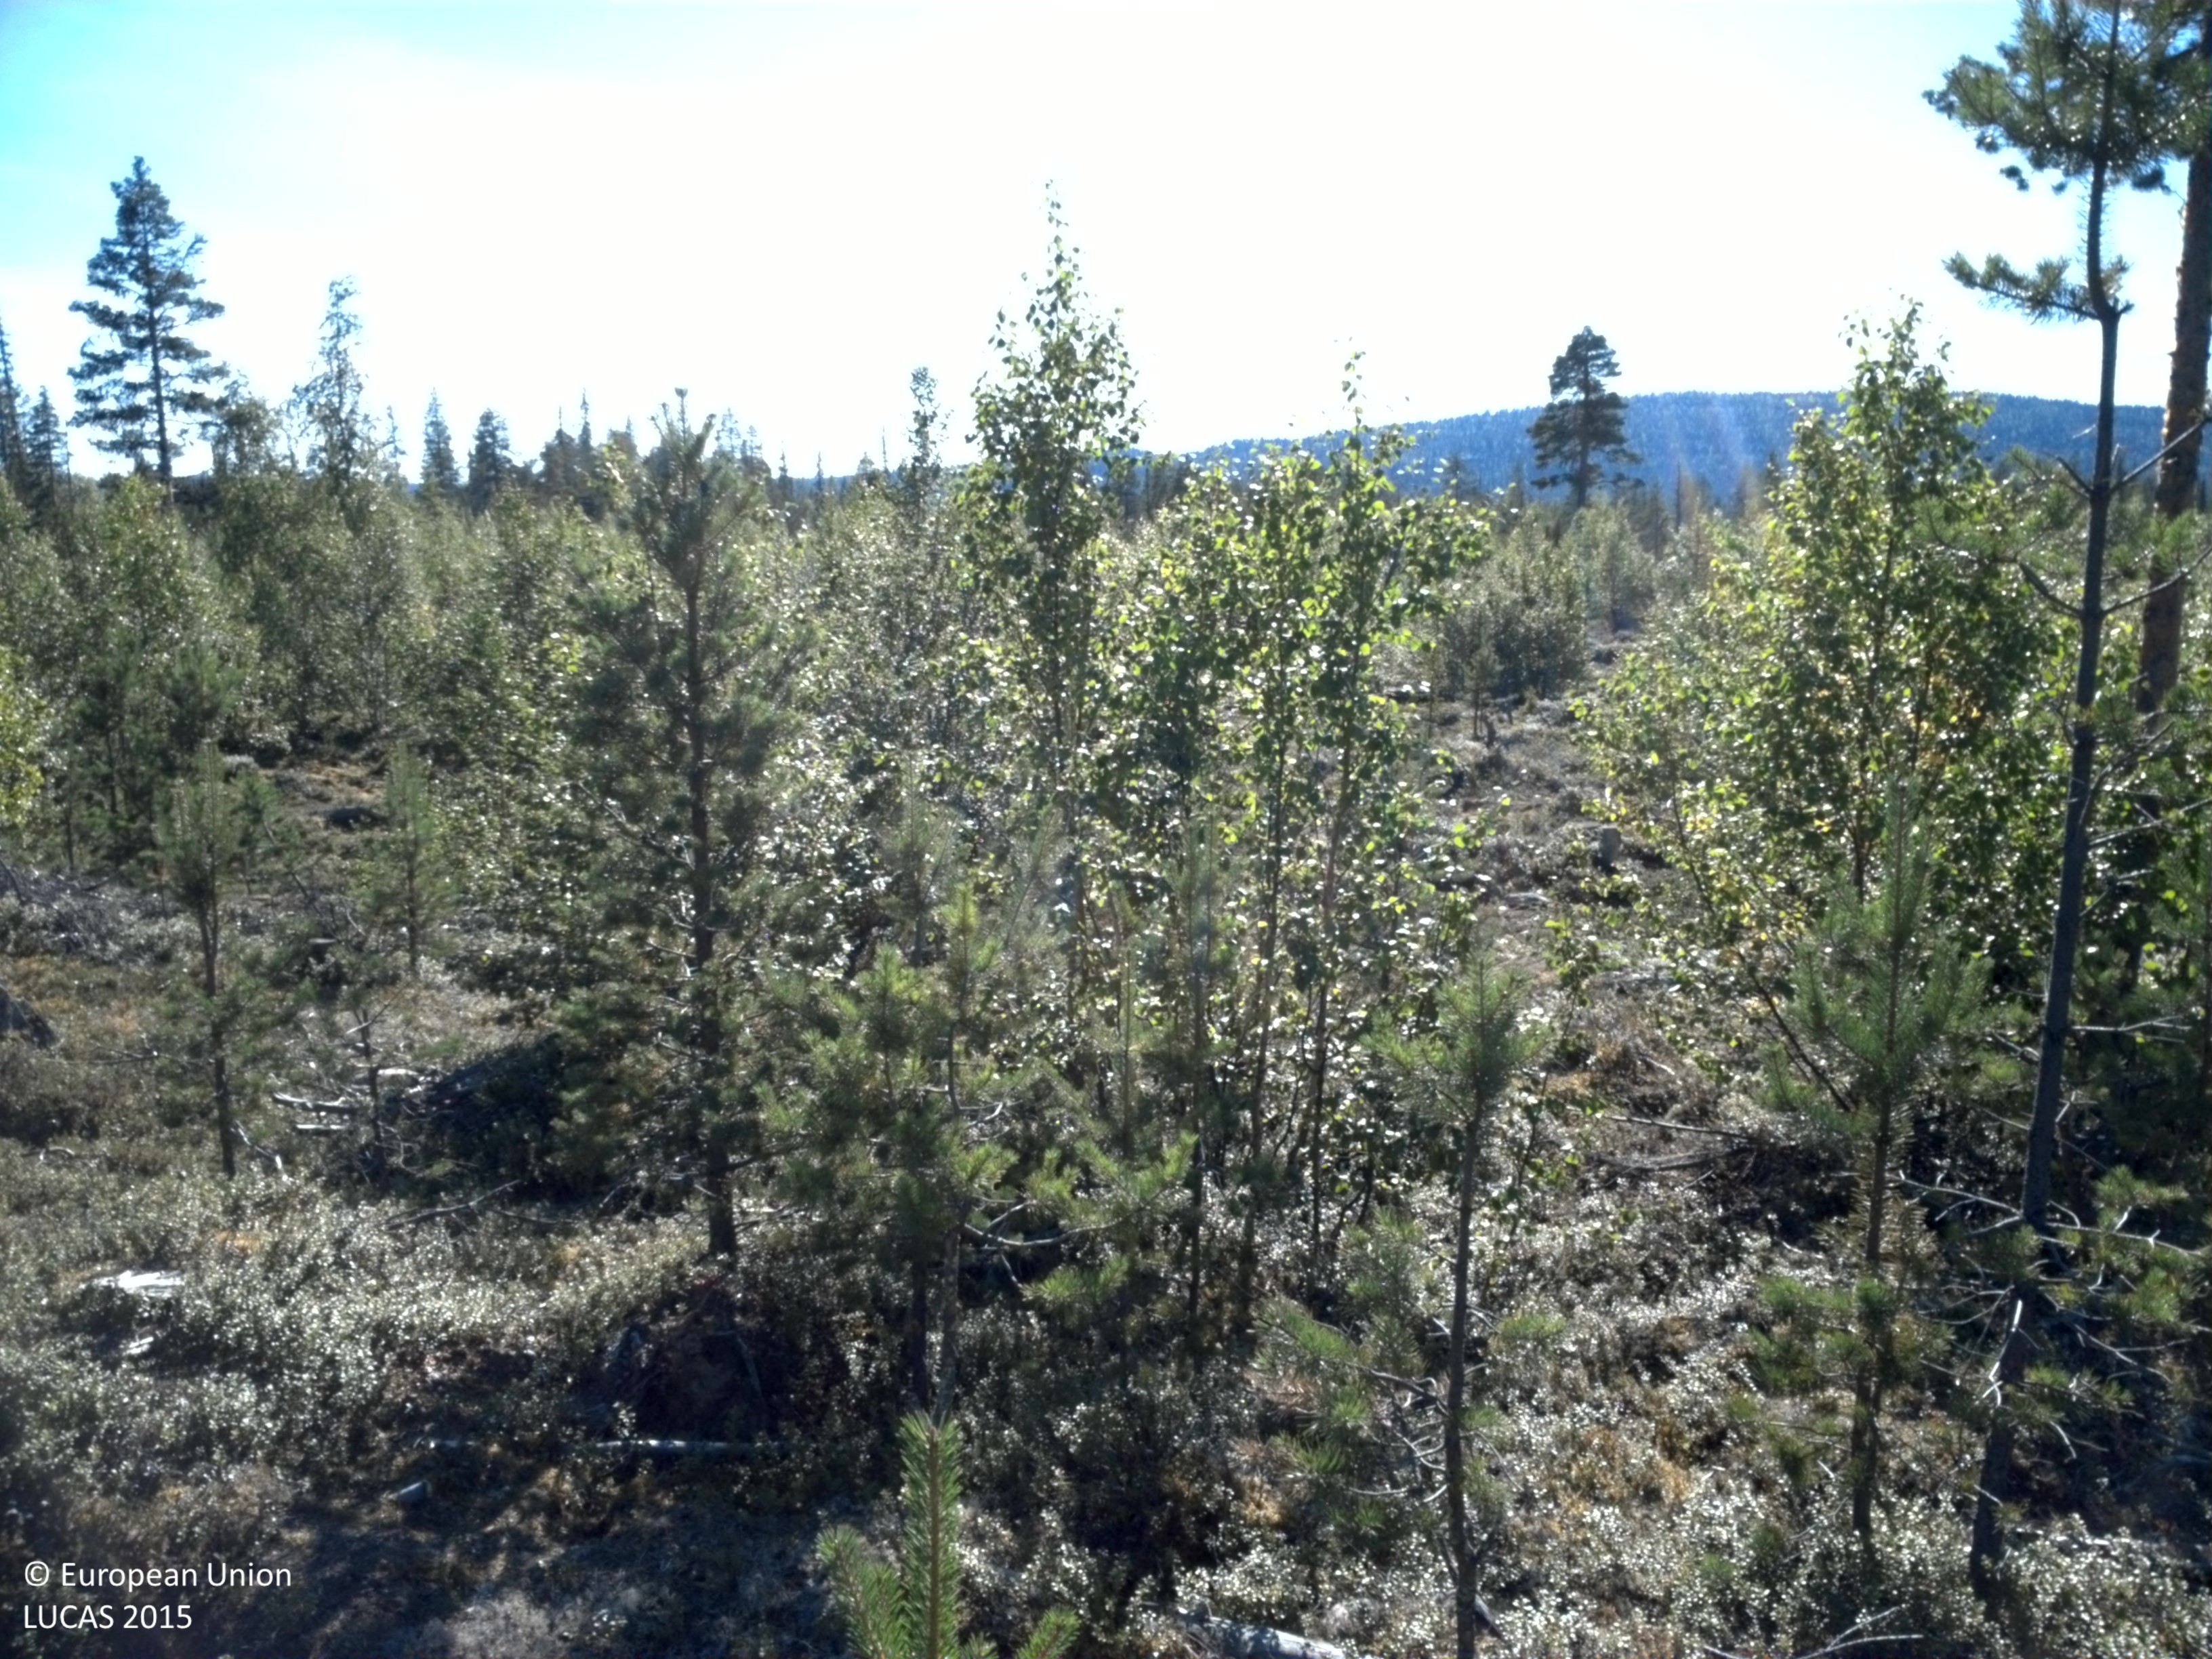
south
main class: Woodland
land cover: Pine dominated mixed woodland
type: boreal forest
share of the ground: 25 - 50 %
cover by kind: shrubs 55 %, broadleaved forest trees 20 %, coniferous forest trees 10 %, lichens and mosses 10 %, consolidated bare surface 5 %
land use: Forestry
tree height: < 5 m
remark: Clear cut
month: August
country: SE
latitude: 66.8101
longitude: 18.8464
